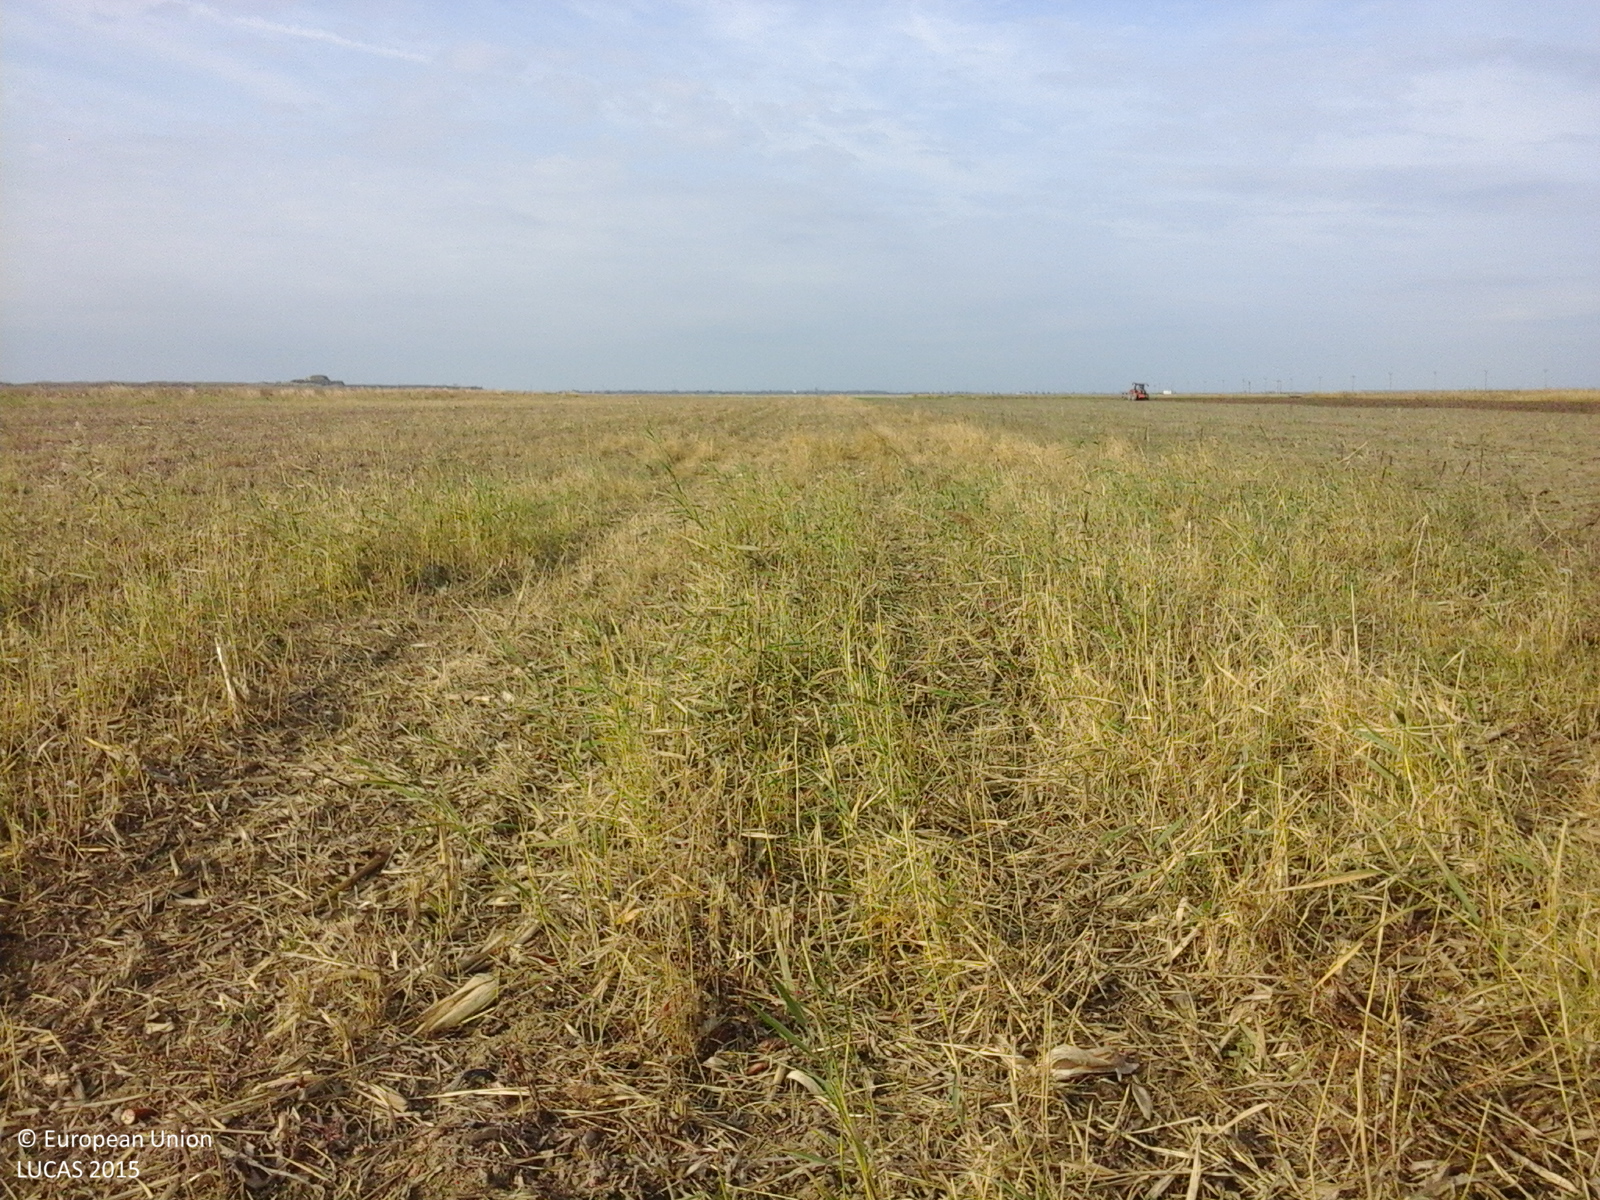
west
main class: Cropland
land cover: Maize
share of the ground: < 10 %
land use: Agriculture (excluding fallow land and kitchen gardens)
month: October
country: RO
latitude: 45.1257
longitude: 27.2160
